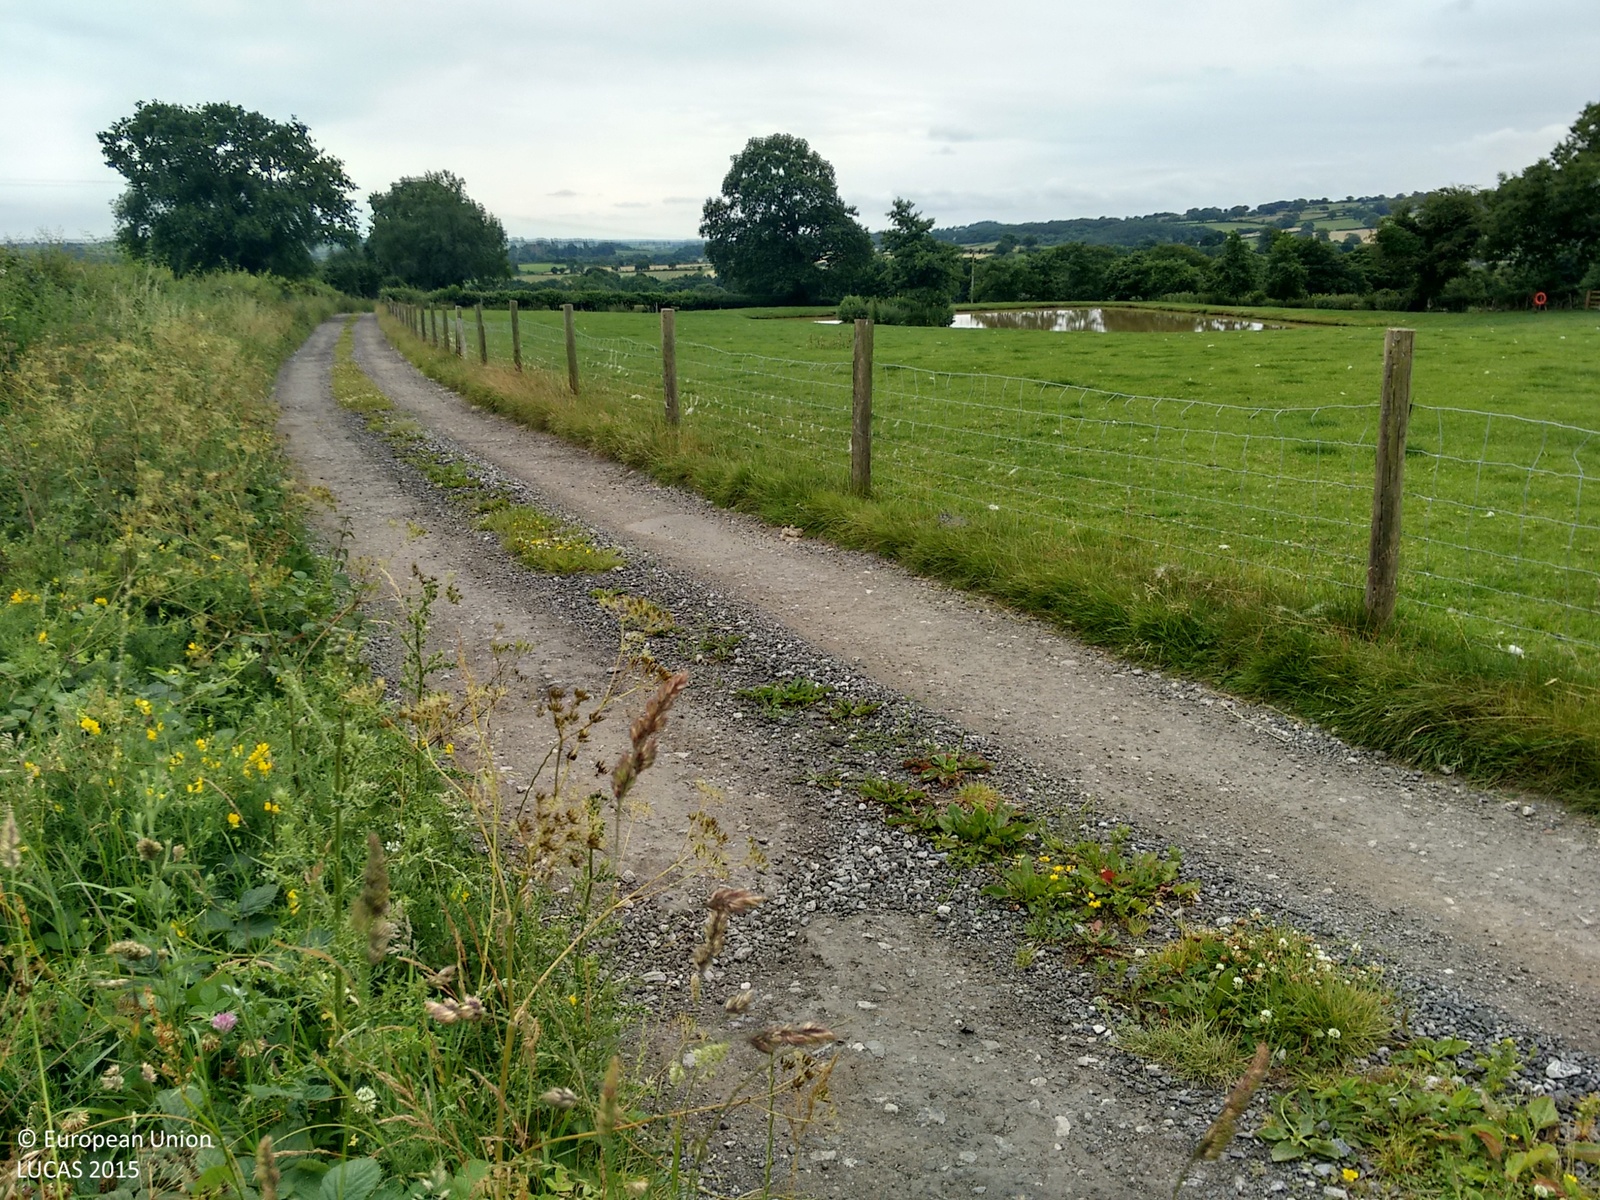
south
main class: Grassland
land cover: Grassland without tree/shrub cover
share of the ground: > 75 %
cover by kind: herbaceous plants 100 %
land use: Agriculture (excluding fallow land and kitchen gardens)
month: July
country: GB
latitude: 53.1113
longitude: -1.4483
